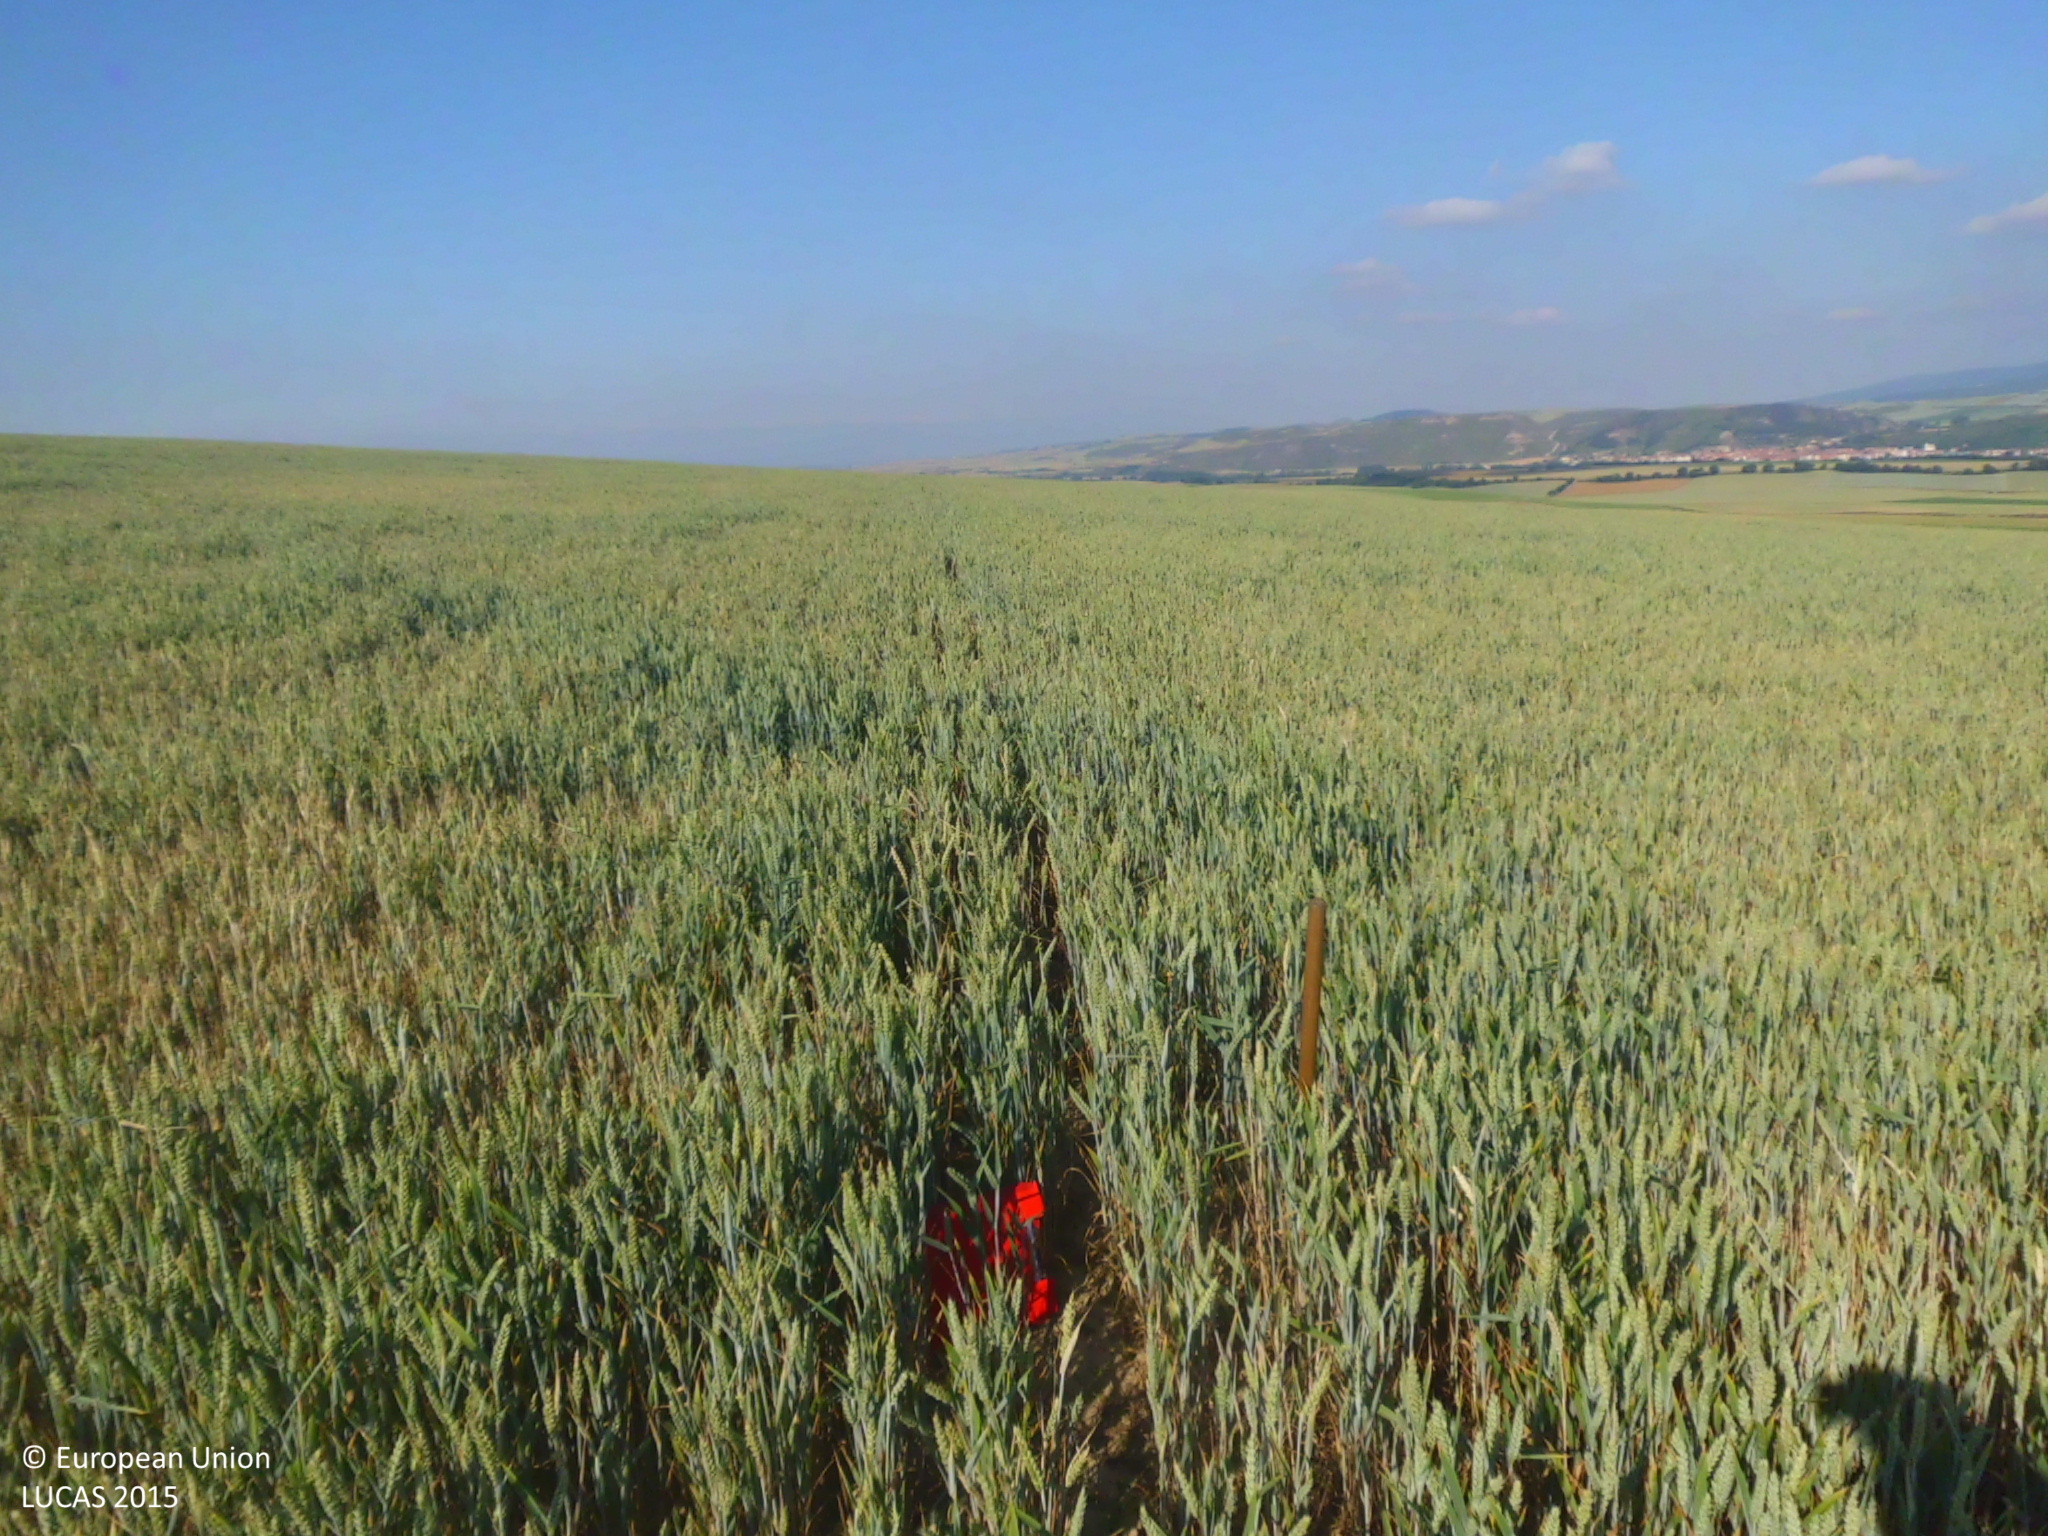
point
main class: Cropland
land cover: Common wheat
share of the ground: > 75 %
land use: Agriculture (excluding fallow land and kitchen gardens)
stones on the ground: < 10 %
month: June
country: ES
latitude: 42.4201
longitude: -3.2407
